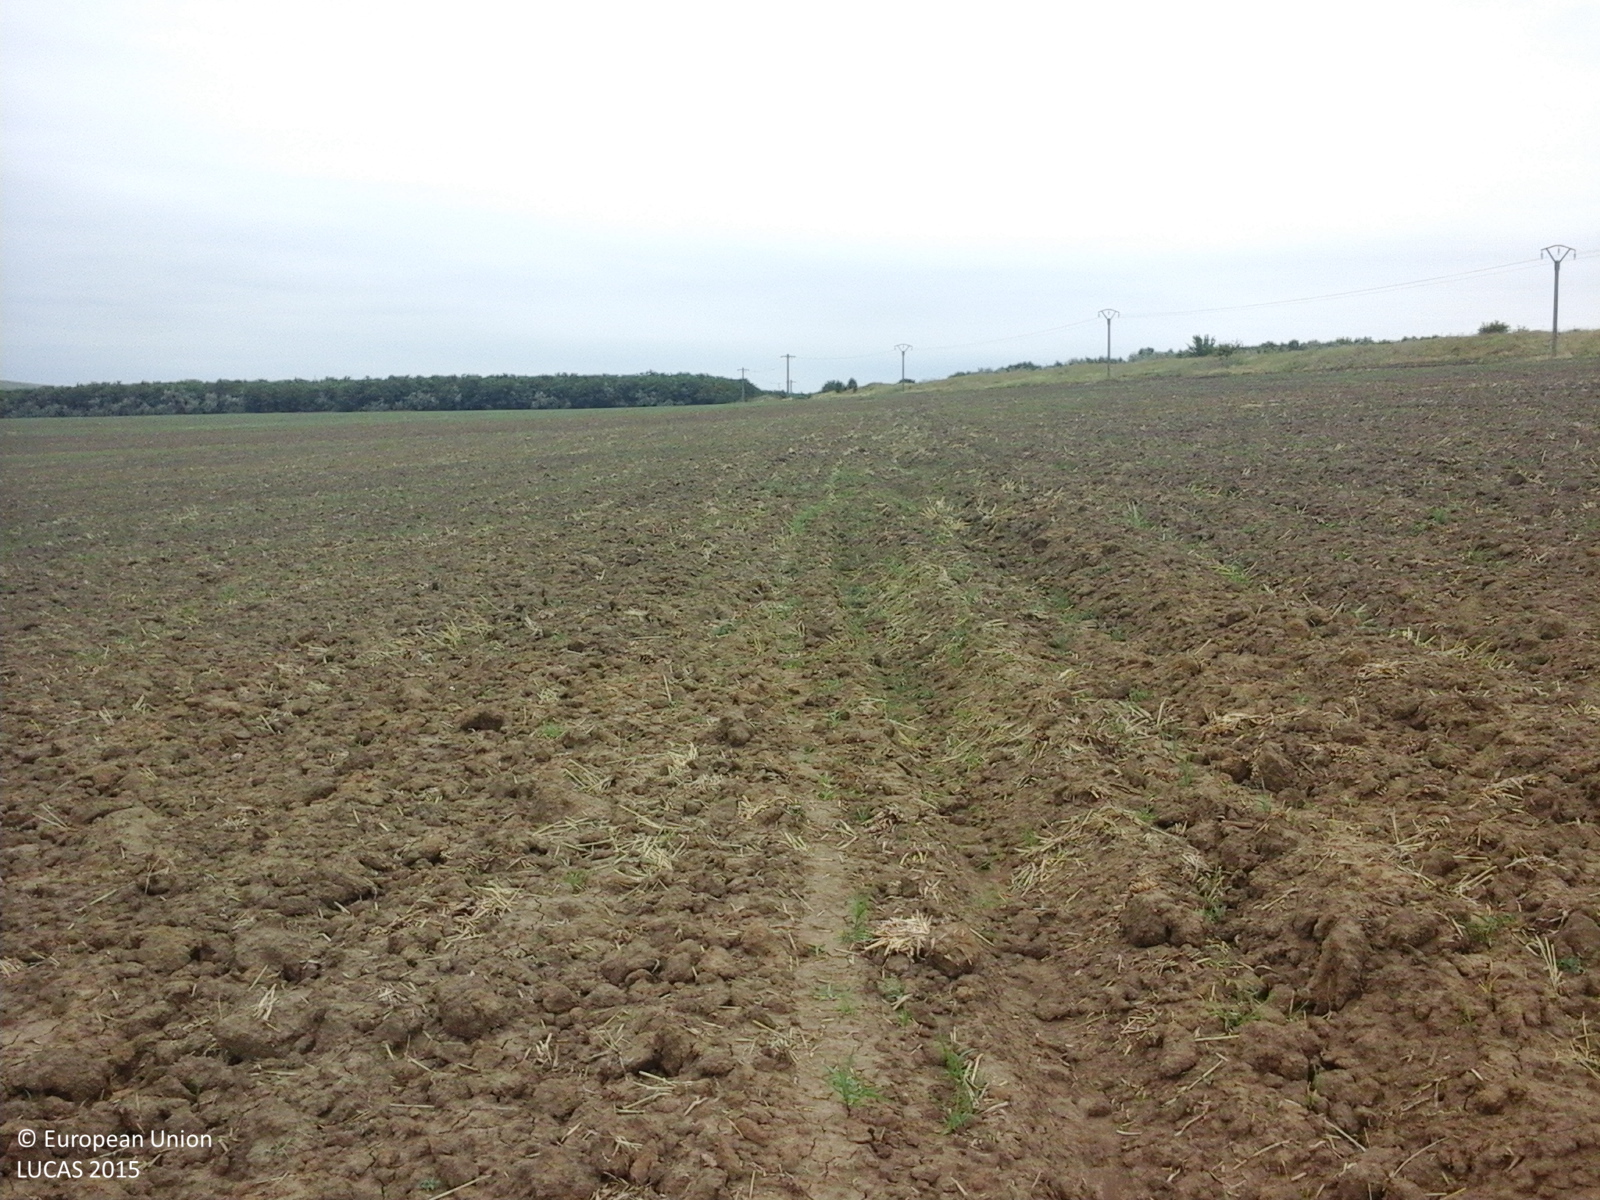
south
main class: Cropland
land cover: Common wheat
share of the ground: < 10 %
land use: Agriculture (excluding fallow land and kitchen gardens)
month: August
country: RO
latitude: 45.1362
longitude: 28.8473
